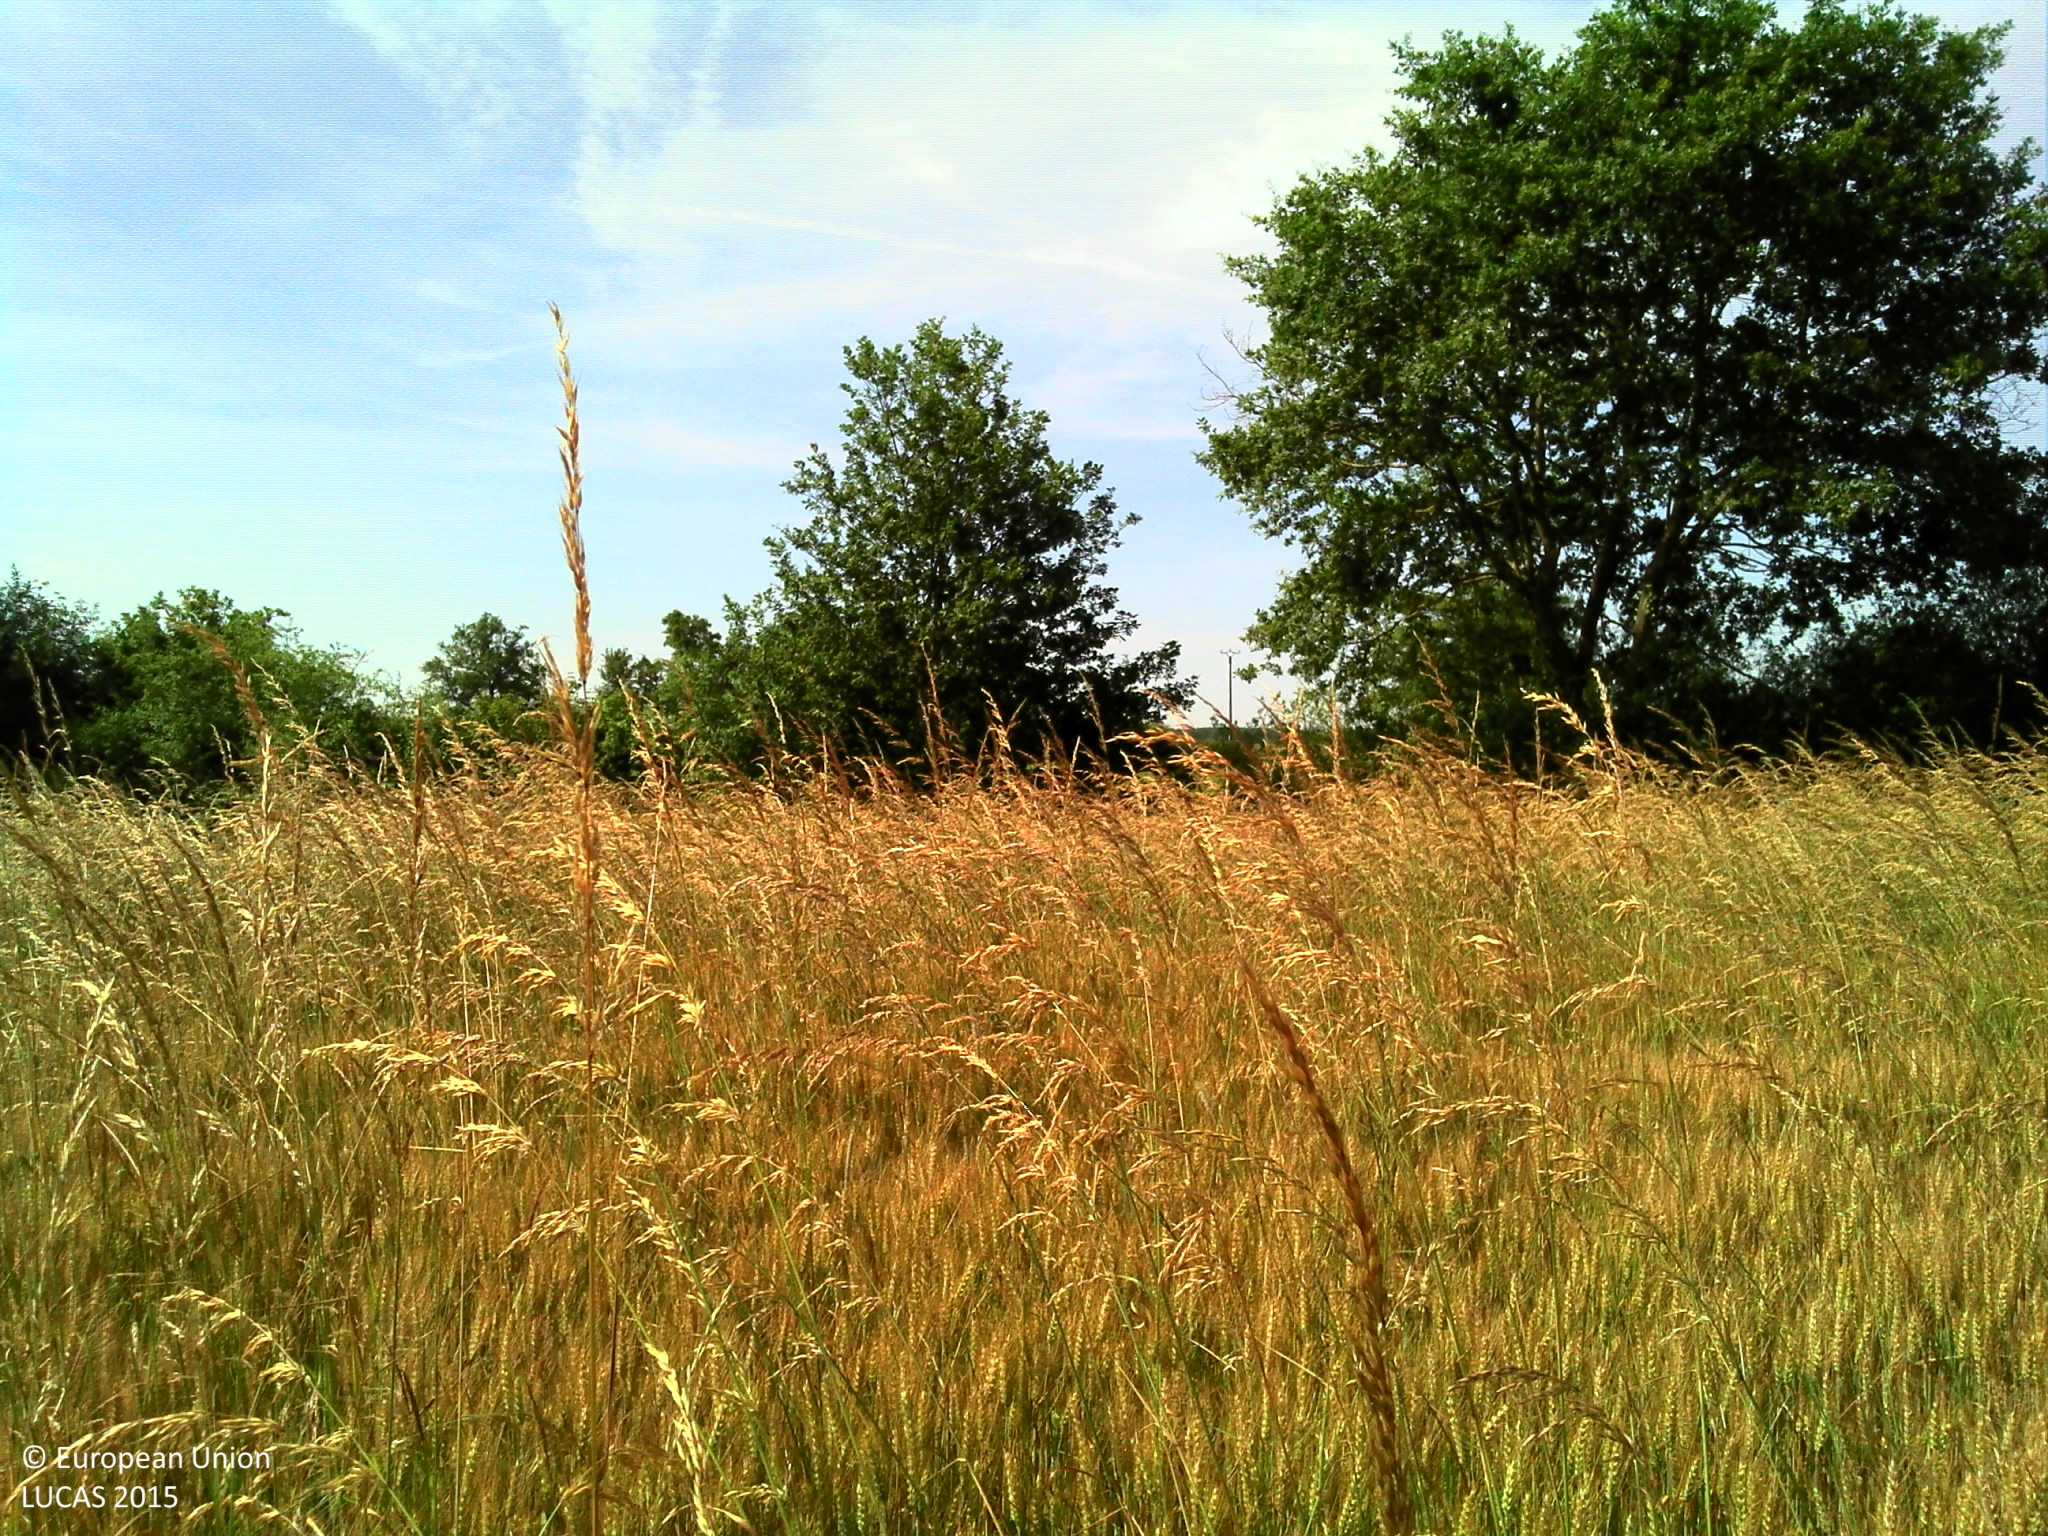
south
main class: Cropland
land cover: Common wheat
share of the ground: > 75 %
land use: Agriculture (excluding fallow land and kitchen gardens)
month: June
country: FR
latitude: 44.4954
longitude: 2.0149
